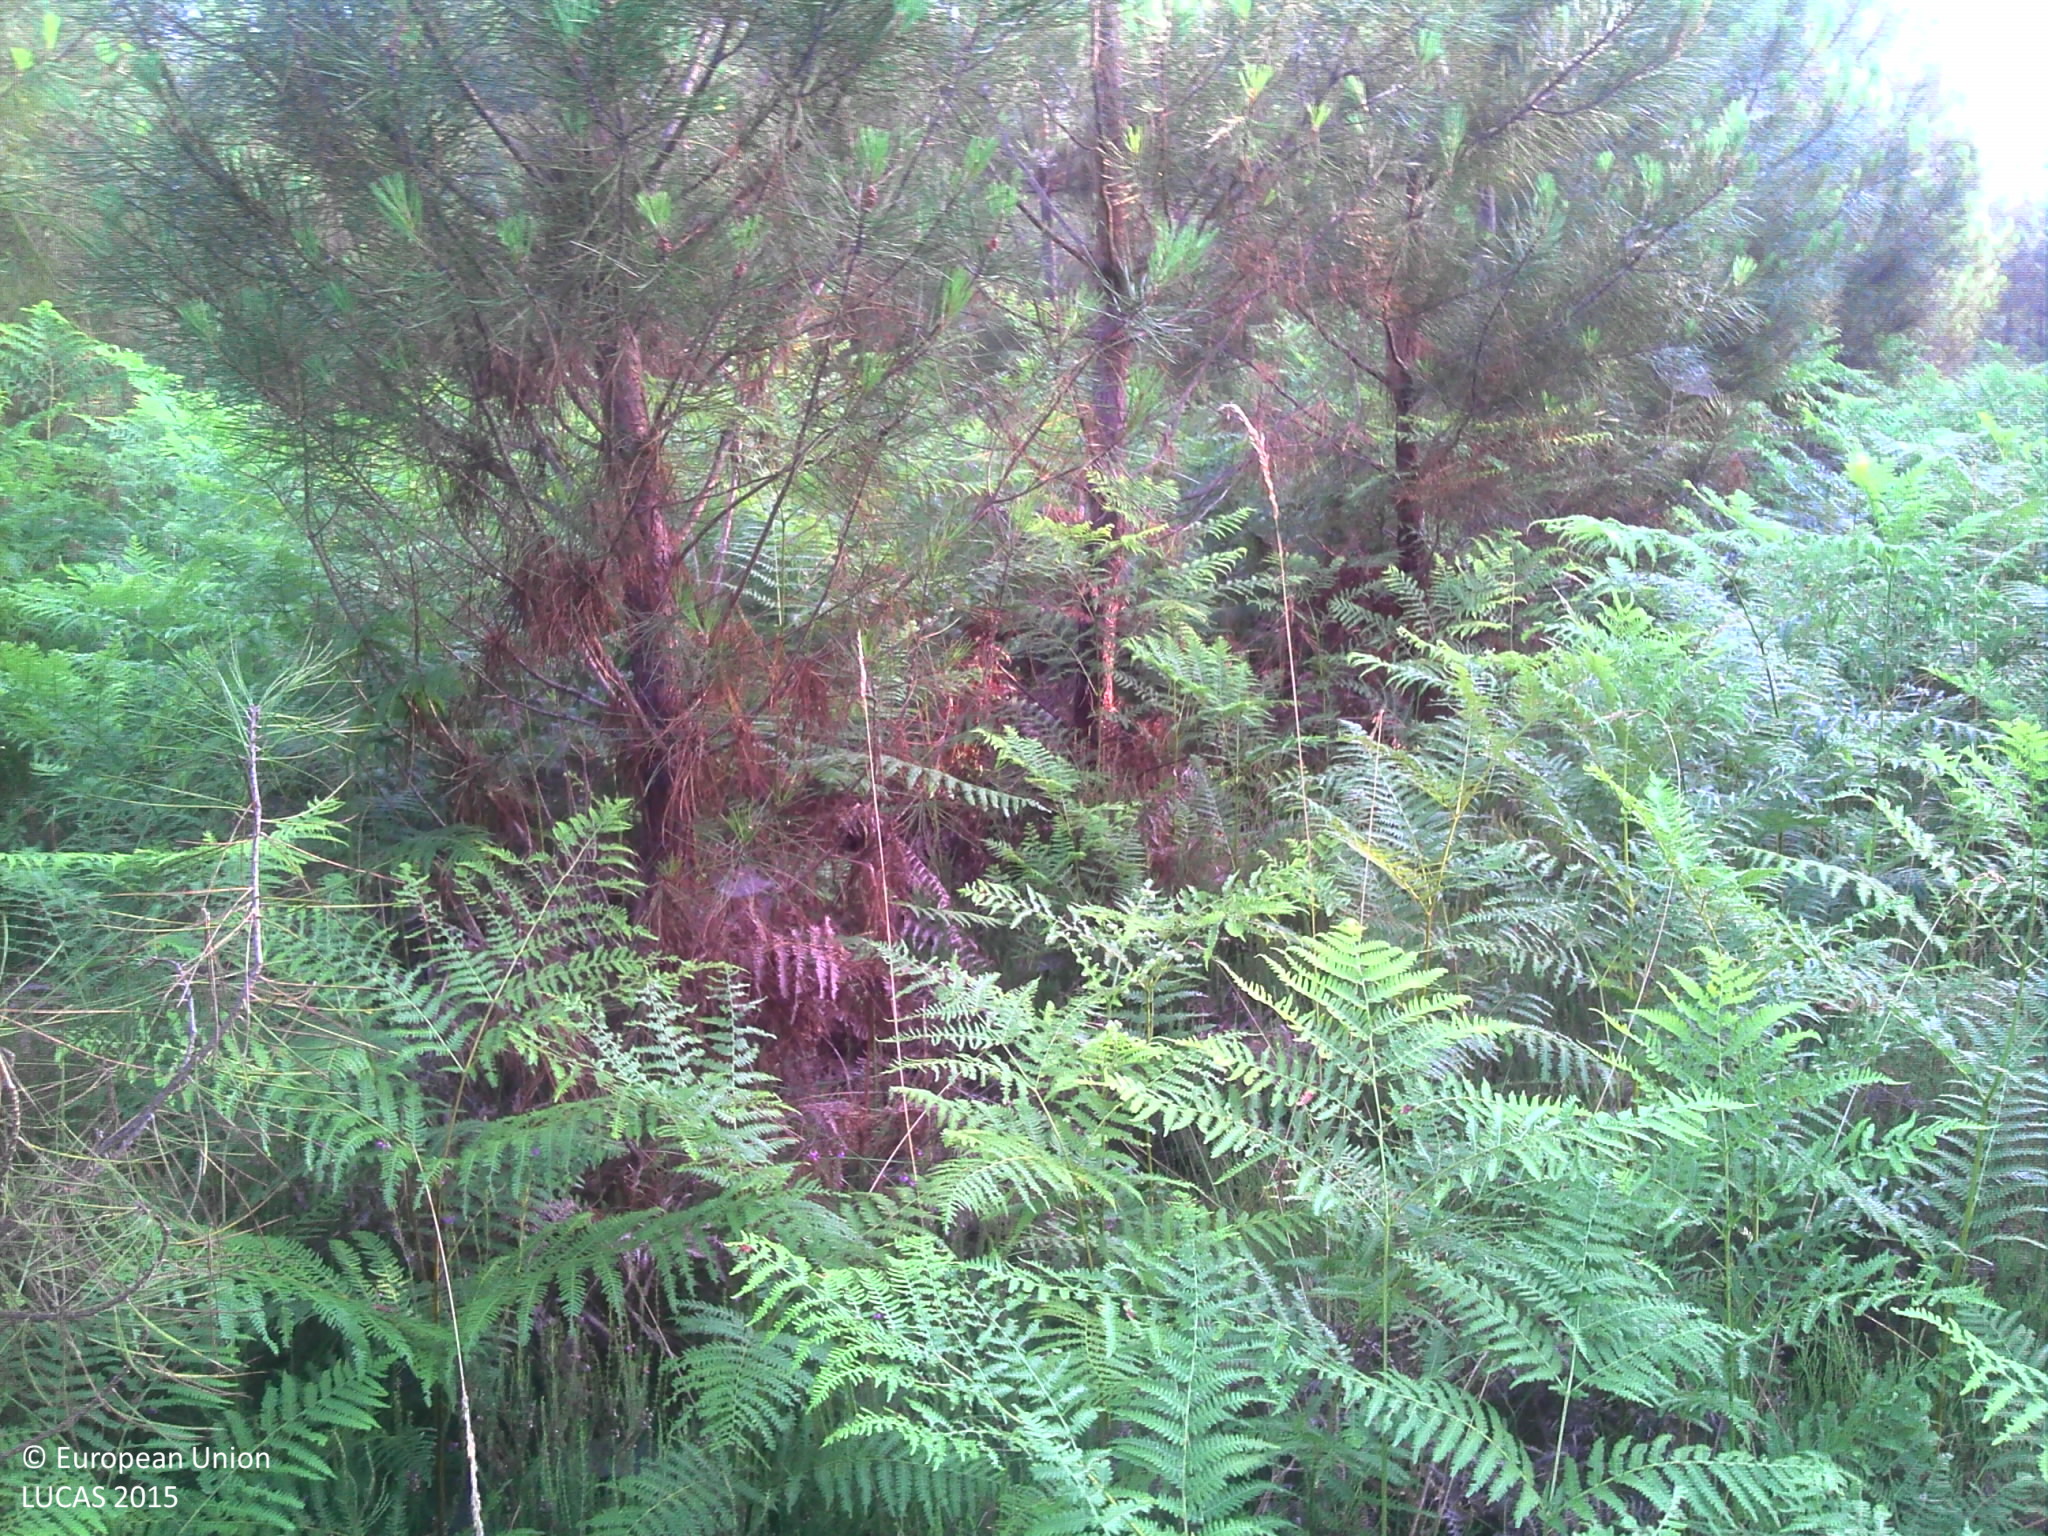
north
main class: Woodland
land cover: Pine dominated coniferous woodland
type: exotic forest
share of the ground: > 75 %
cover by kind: coniferous forest trees 70 %, herbaceous plants 30 %
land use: Forestry
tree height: > 5 m
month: July
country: FR
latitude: 44.1277
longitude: -0.2973
